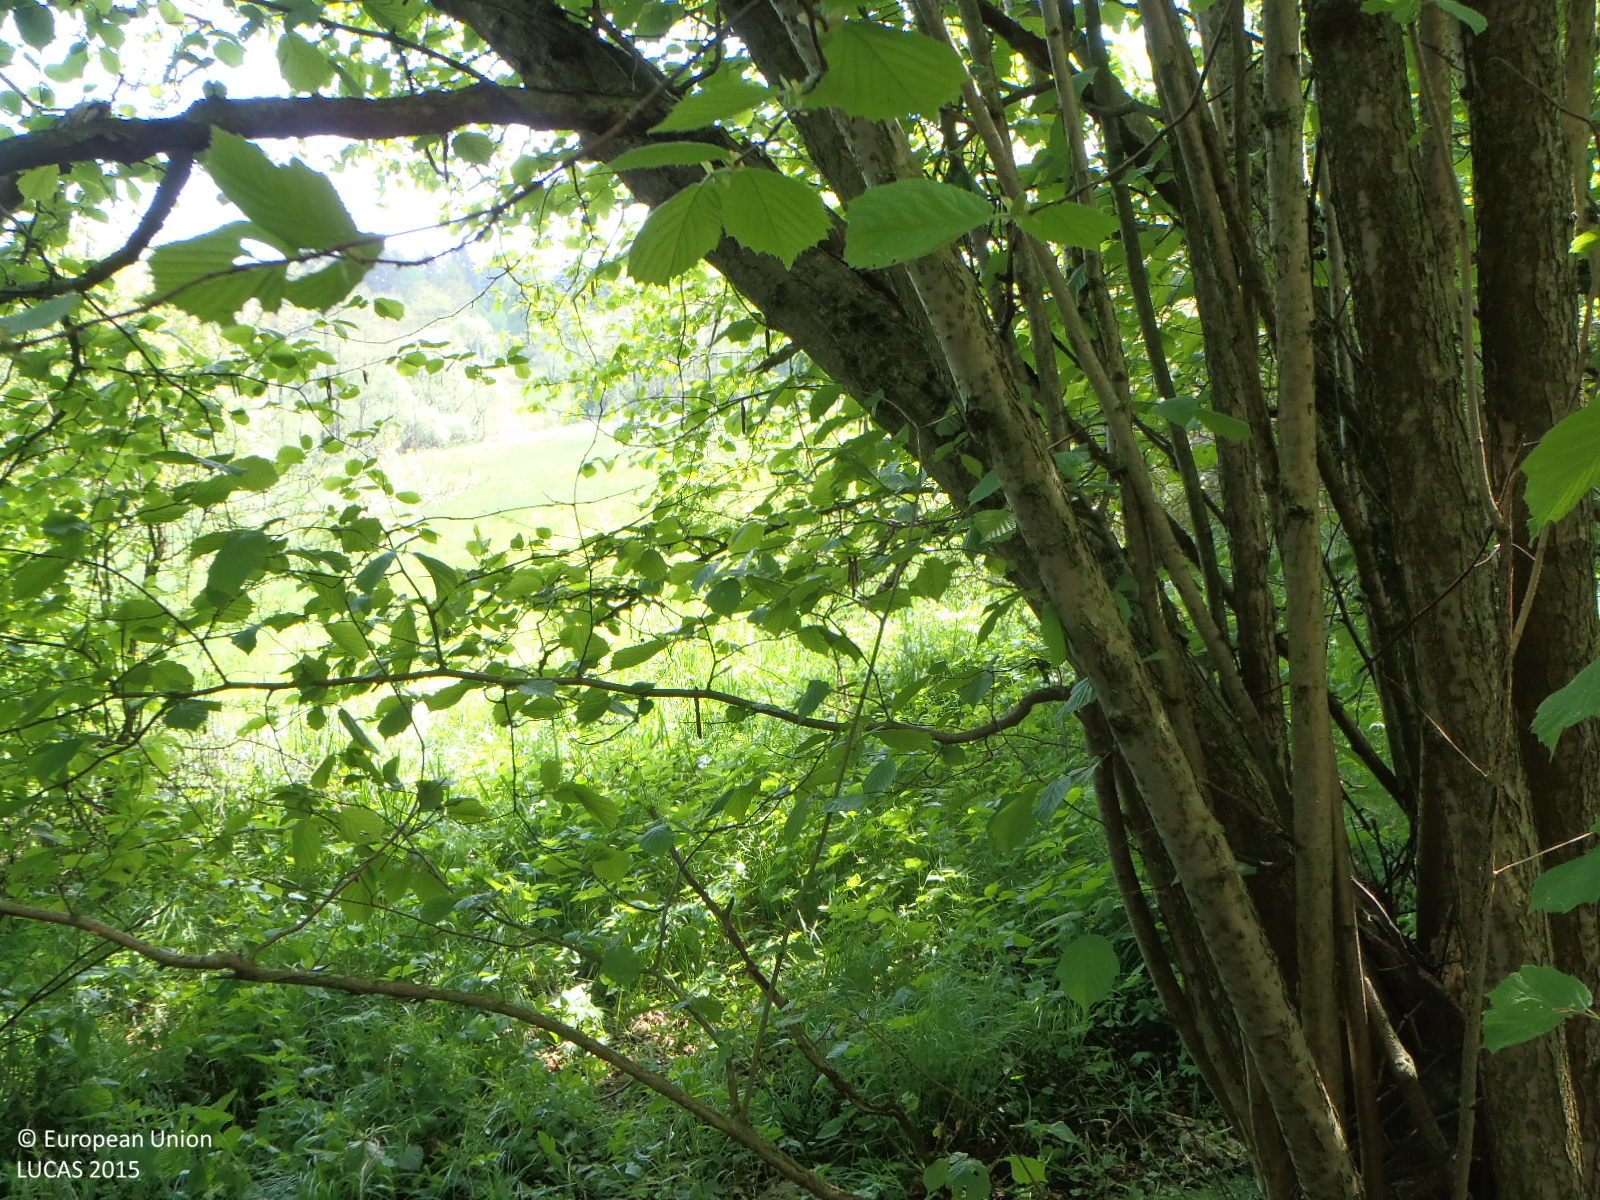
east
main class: Woodland
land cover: Broadleaved woodland
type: mesophytic deciduous forest
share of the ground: > 75 %
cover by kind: broadleaved forest trees 90 %, lichens and mosses 5 %, unconsolidated bare surface 5 %
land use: Semi-natural and natural areas not in use
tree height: > 5 m
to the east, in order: Broadleaved woodland; Fences; Grassland without tree/shrub cover; Fences; Spontaneously vegetated surfaces; Broadleaved woodland; Rivers and streams; Broadleaved woodland; Ditches and canals; Broadleaved woodland; Grassland with sparse tree/shrub cover; Grassland without tree/shrub cover; Ditches and canals; Shrubland without tree cover; Electric lines; Grassland without tree/shrub cover
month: May
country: CZ
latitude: 49.0452
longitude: 15.0506
